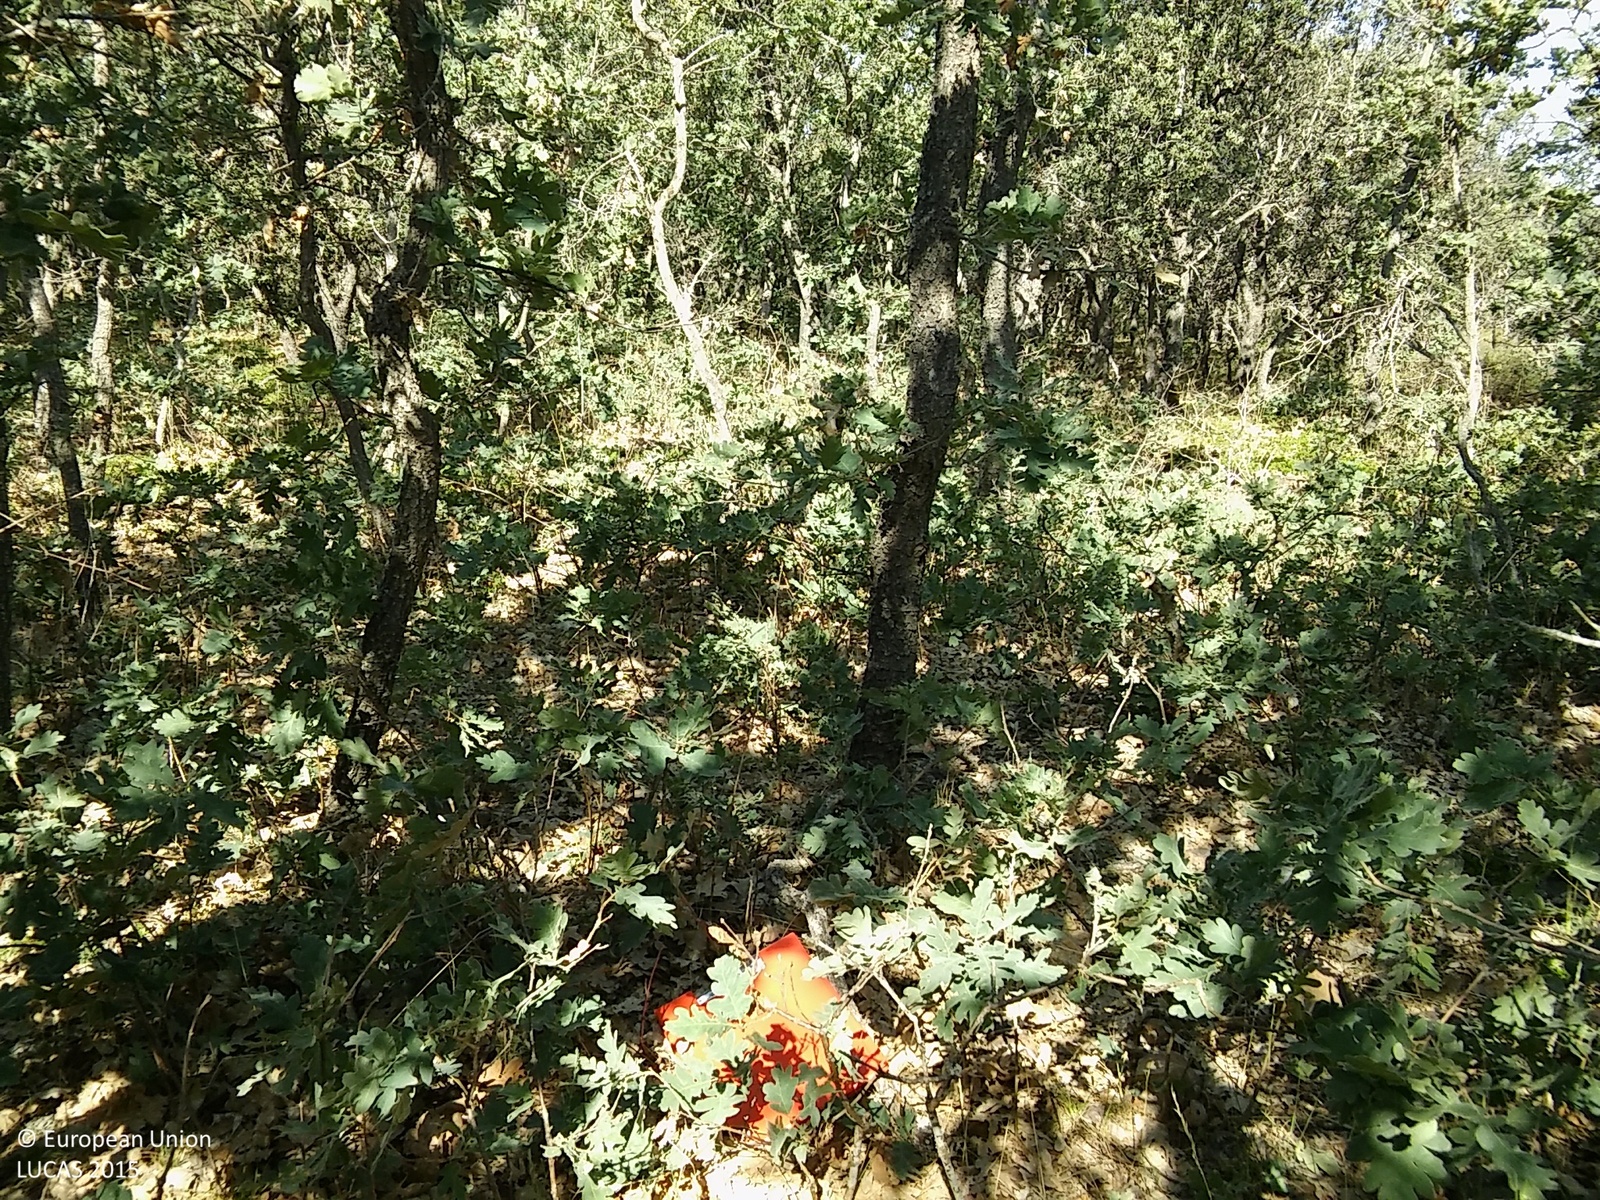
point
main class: Woodland
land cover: Broadleaved woodland
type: thermophilous deciduous forest
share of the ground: 50 - 75 %
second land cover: Shrubland without tree cover
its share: 25 - 50 %
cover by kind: broadleaved forest trees 50 %, shrubs 30 %, herbaceous plants 10 %, lichens and mosses 10 %
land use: Forestry
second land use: Agriculture (excluding fallow land and kitchen gardens)
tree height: > 5 m
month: July
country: ES
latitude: 41.3444
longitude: -3.4909
